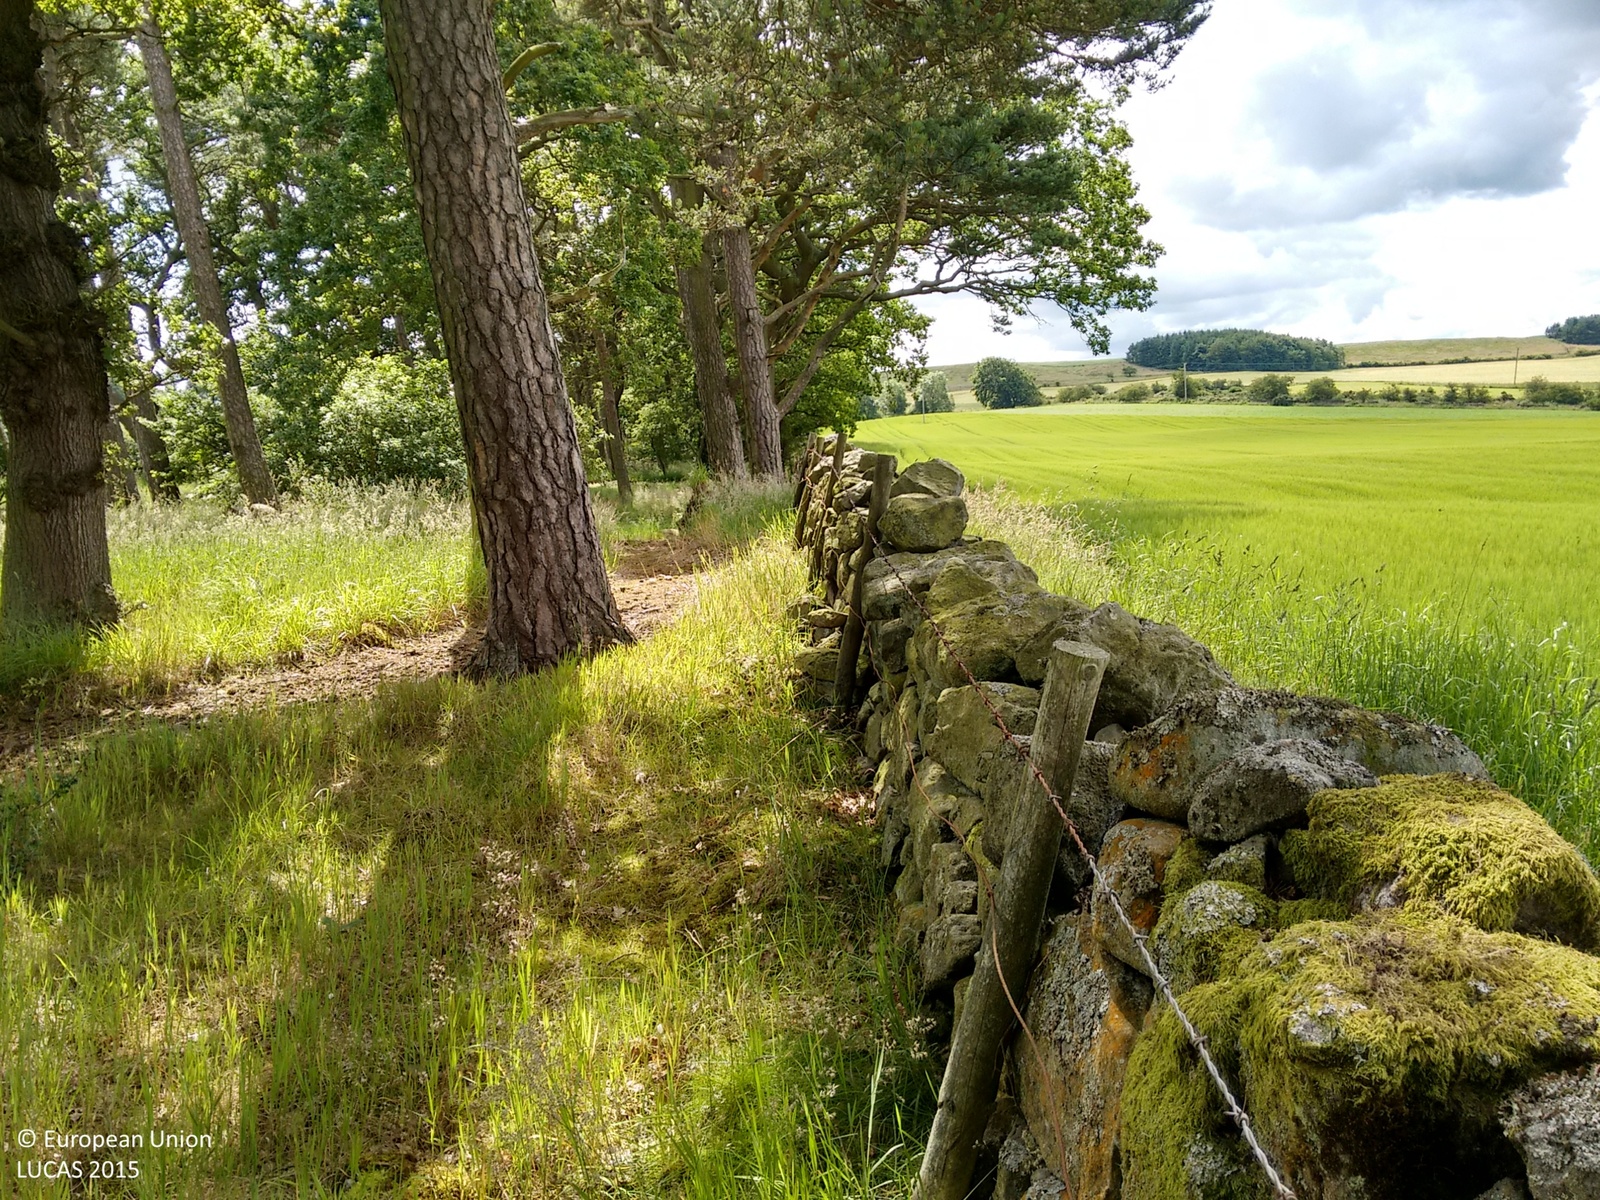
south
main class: Woodland
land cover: Pine dominated mixed woodland
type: exotic forest
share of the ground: > 75 %
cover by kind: coniferous forest trees 65 %, broadleaved forest trees 25 %, herbaceous plants 10 %
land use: Agriculture (excluding fallow land and kitchen gardens)
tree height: > 5 m
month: July
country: GB
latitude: 56.1060
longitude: -3.6994
